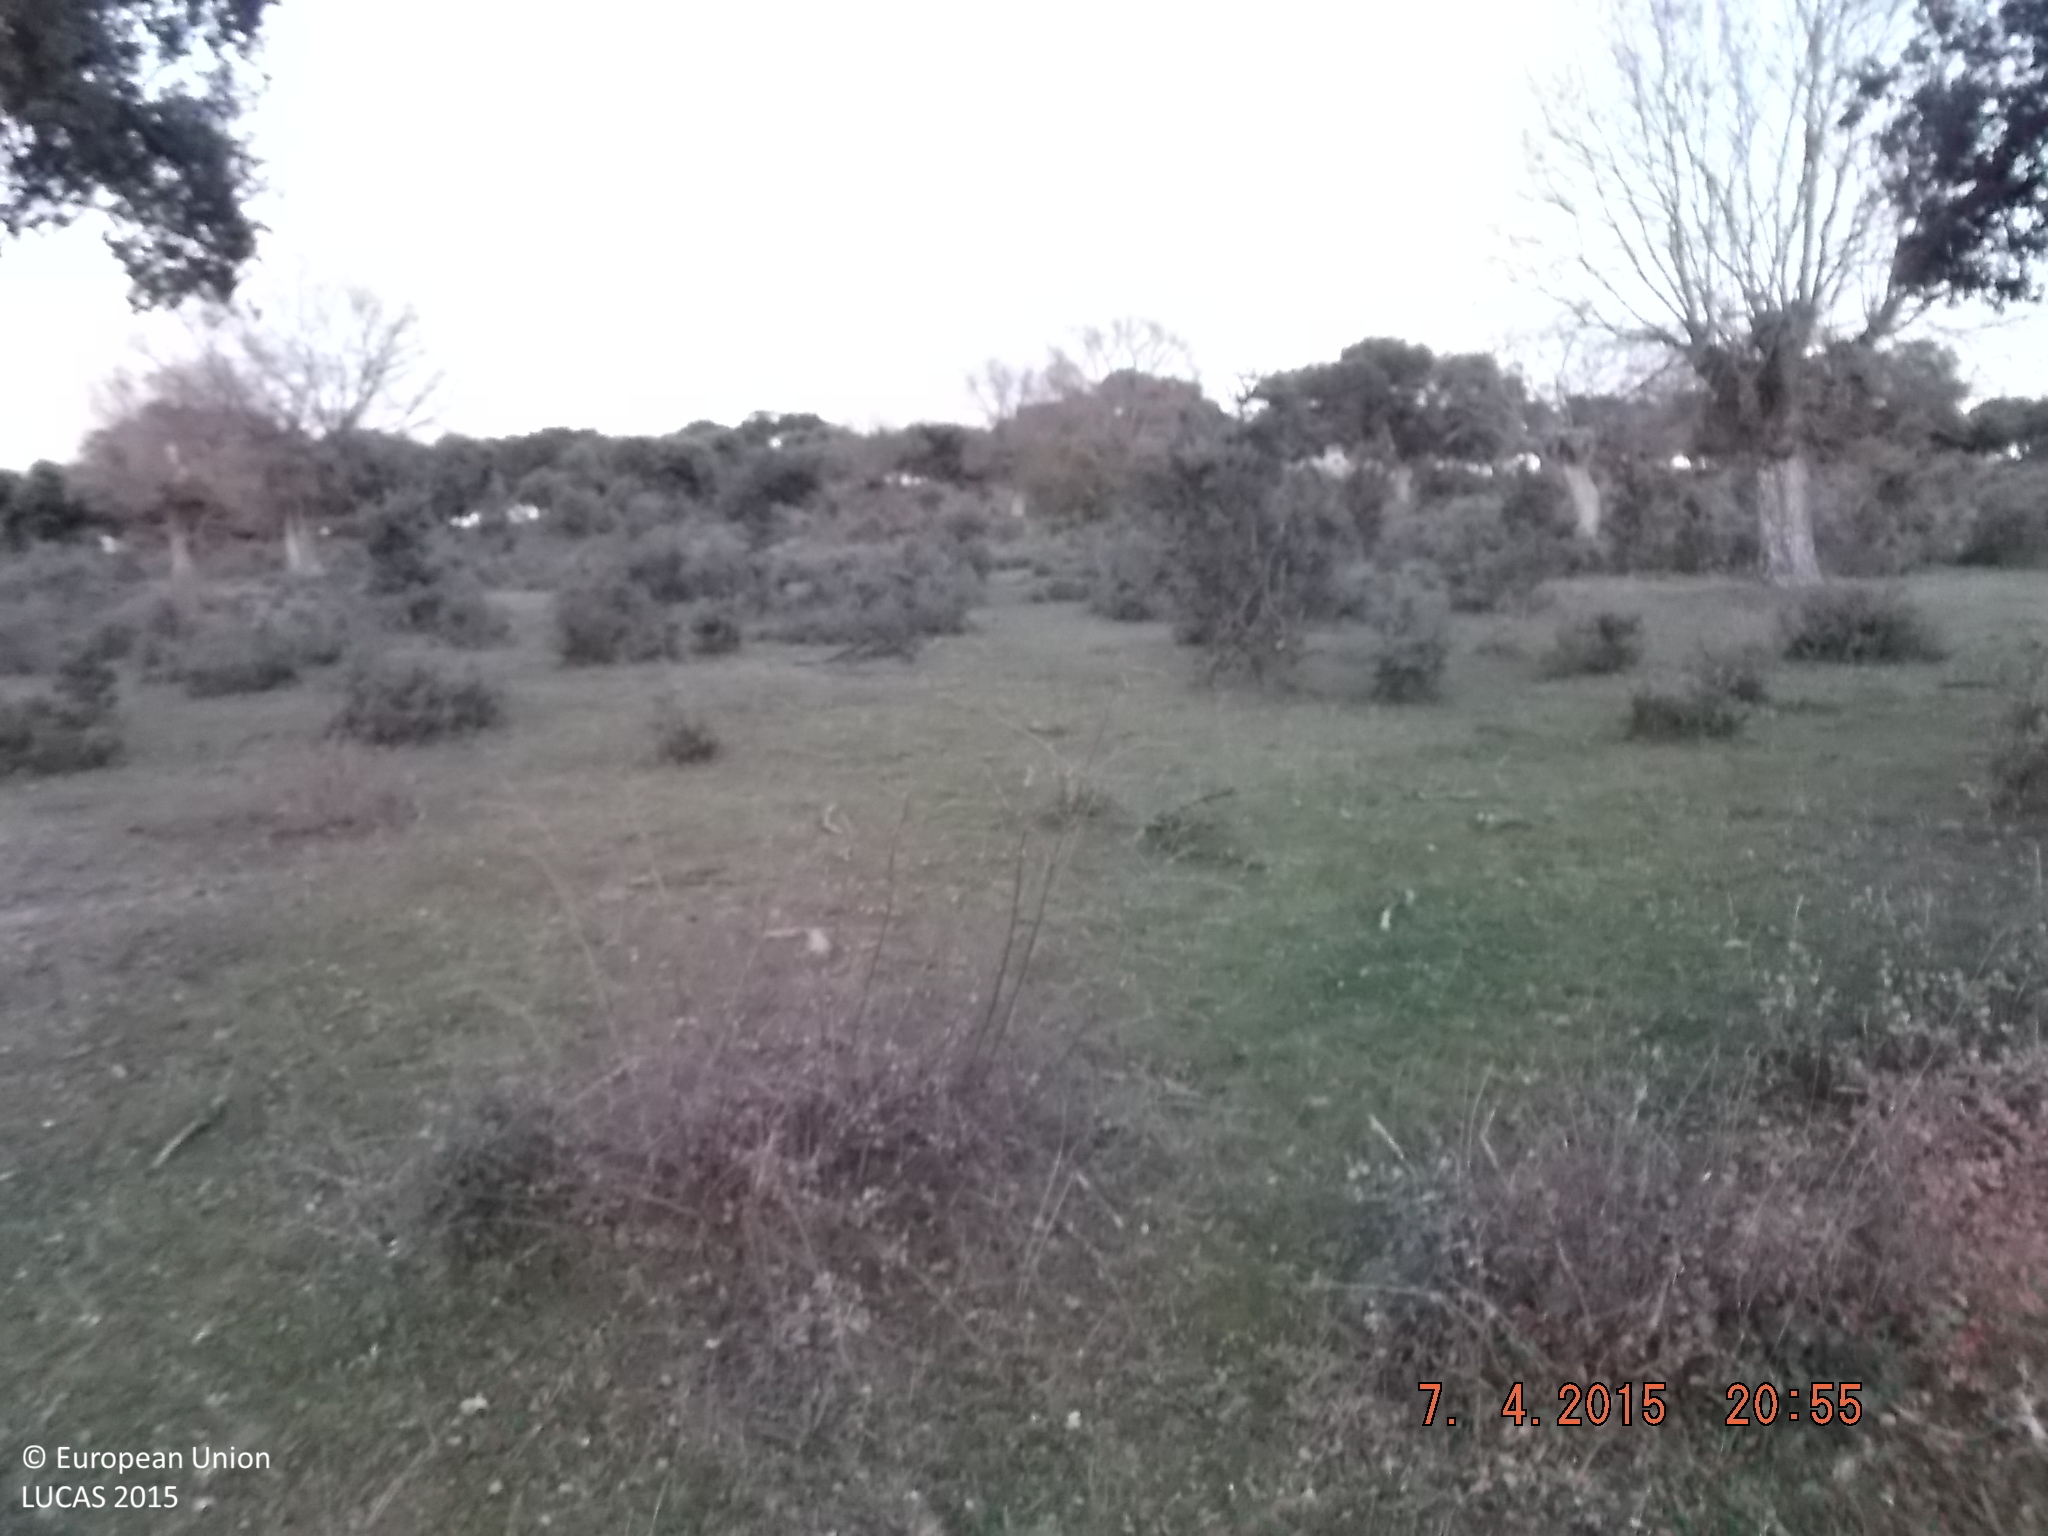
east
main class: Woodland
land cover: Broadleaved woodland
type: broadleaved evergreen forest
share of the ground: 25 - 50 %
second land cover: Shrubland without tree cover
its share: 50 - 75 %
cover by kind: shrubs 50 %, broadleaved forest trees 40 %, herbaceous plants 10 %
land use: Forestry
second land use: Agriculture (excluding fallow land and kitchen gardens)
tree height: < 5 m
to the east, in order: Broadleaved woodland; Shrubland without tree cover; Broadleaved woodland; Fences; Broadleaved woodland; Tracks; Broadleaved woodland
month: April
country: ES
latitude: 40.8253
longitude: -5.8611
